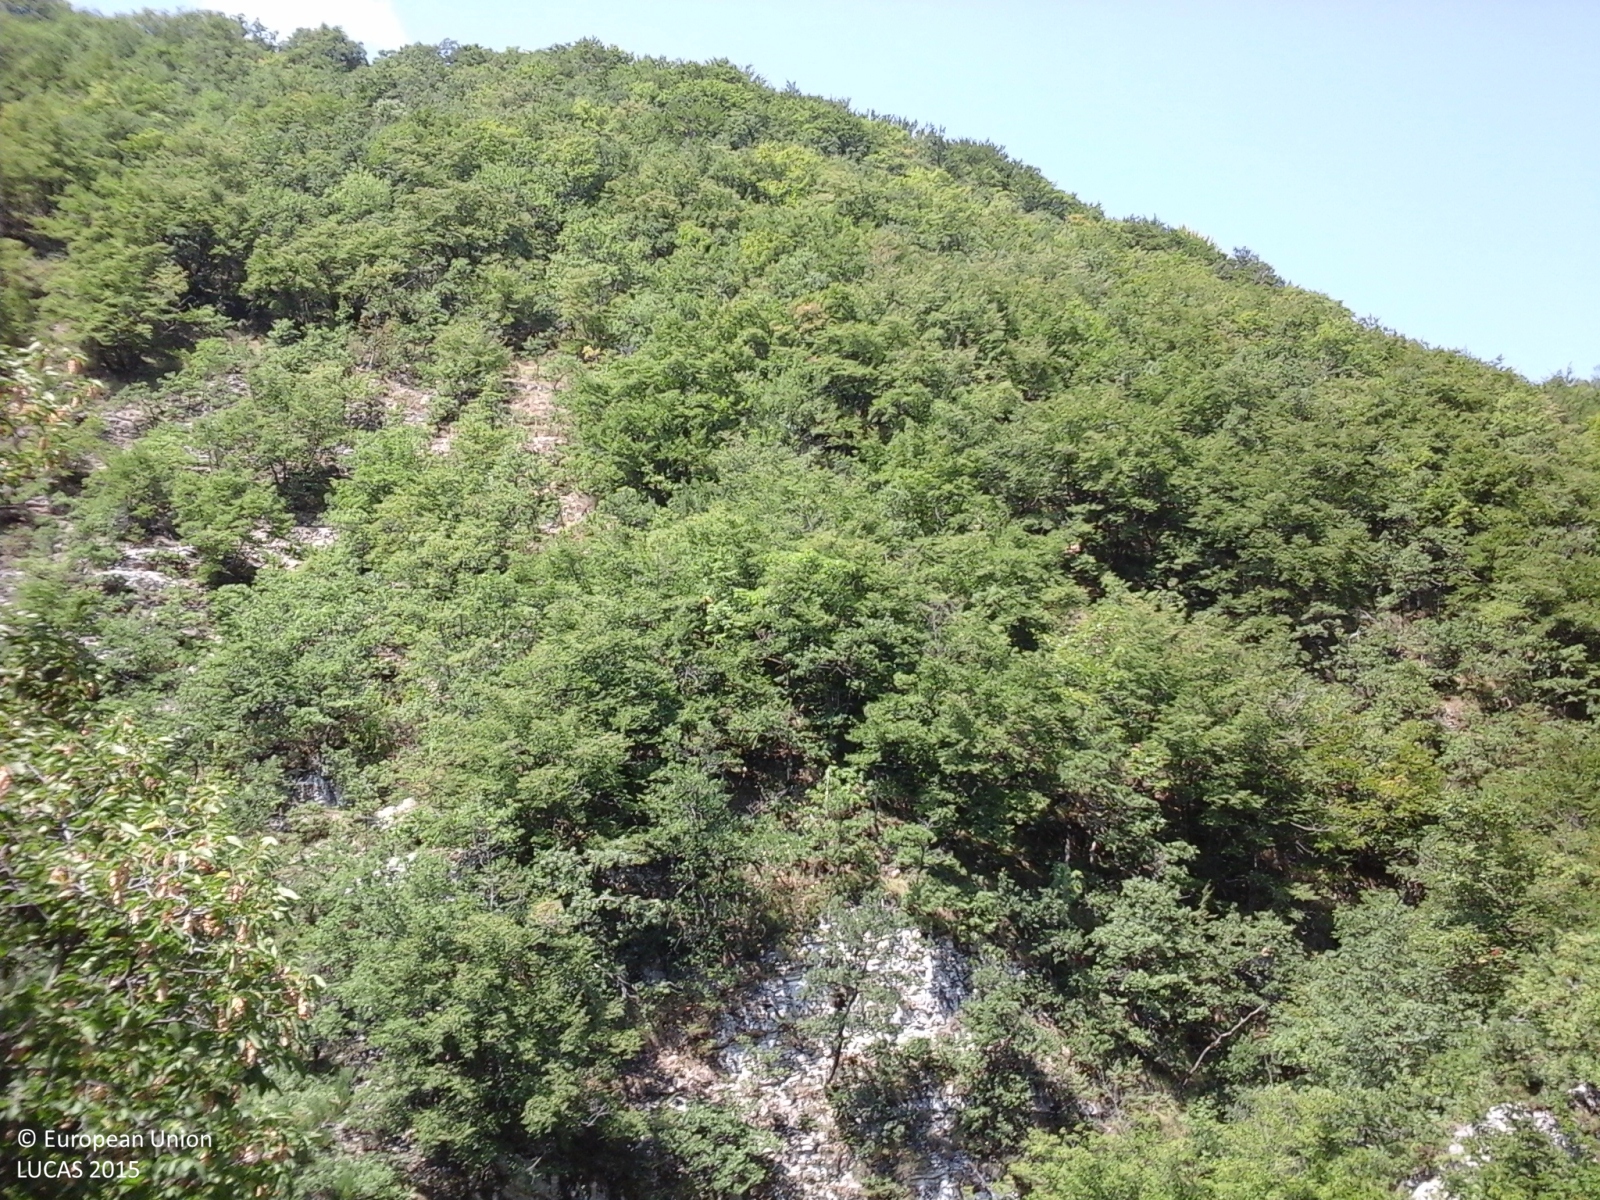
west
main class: Woodland
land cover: Broadleaved woodland
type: thermophilous deciduous forest
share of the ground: > 75 %
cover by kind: broadleaved forest trees 100 %
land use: Forestry
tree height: < 5 m
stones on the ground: > 50 %
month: August
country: IT
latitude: 42.9667
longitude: 13.1419
